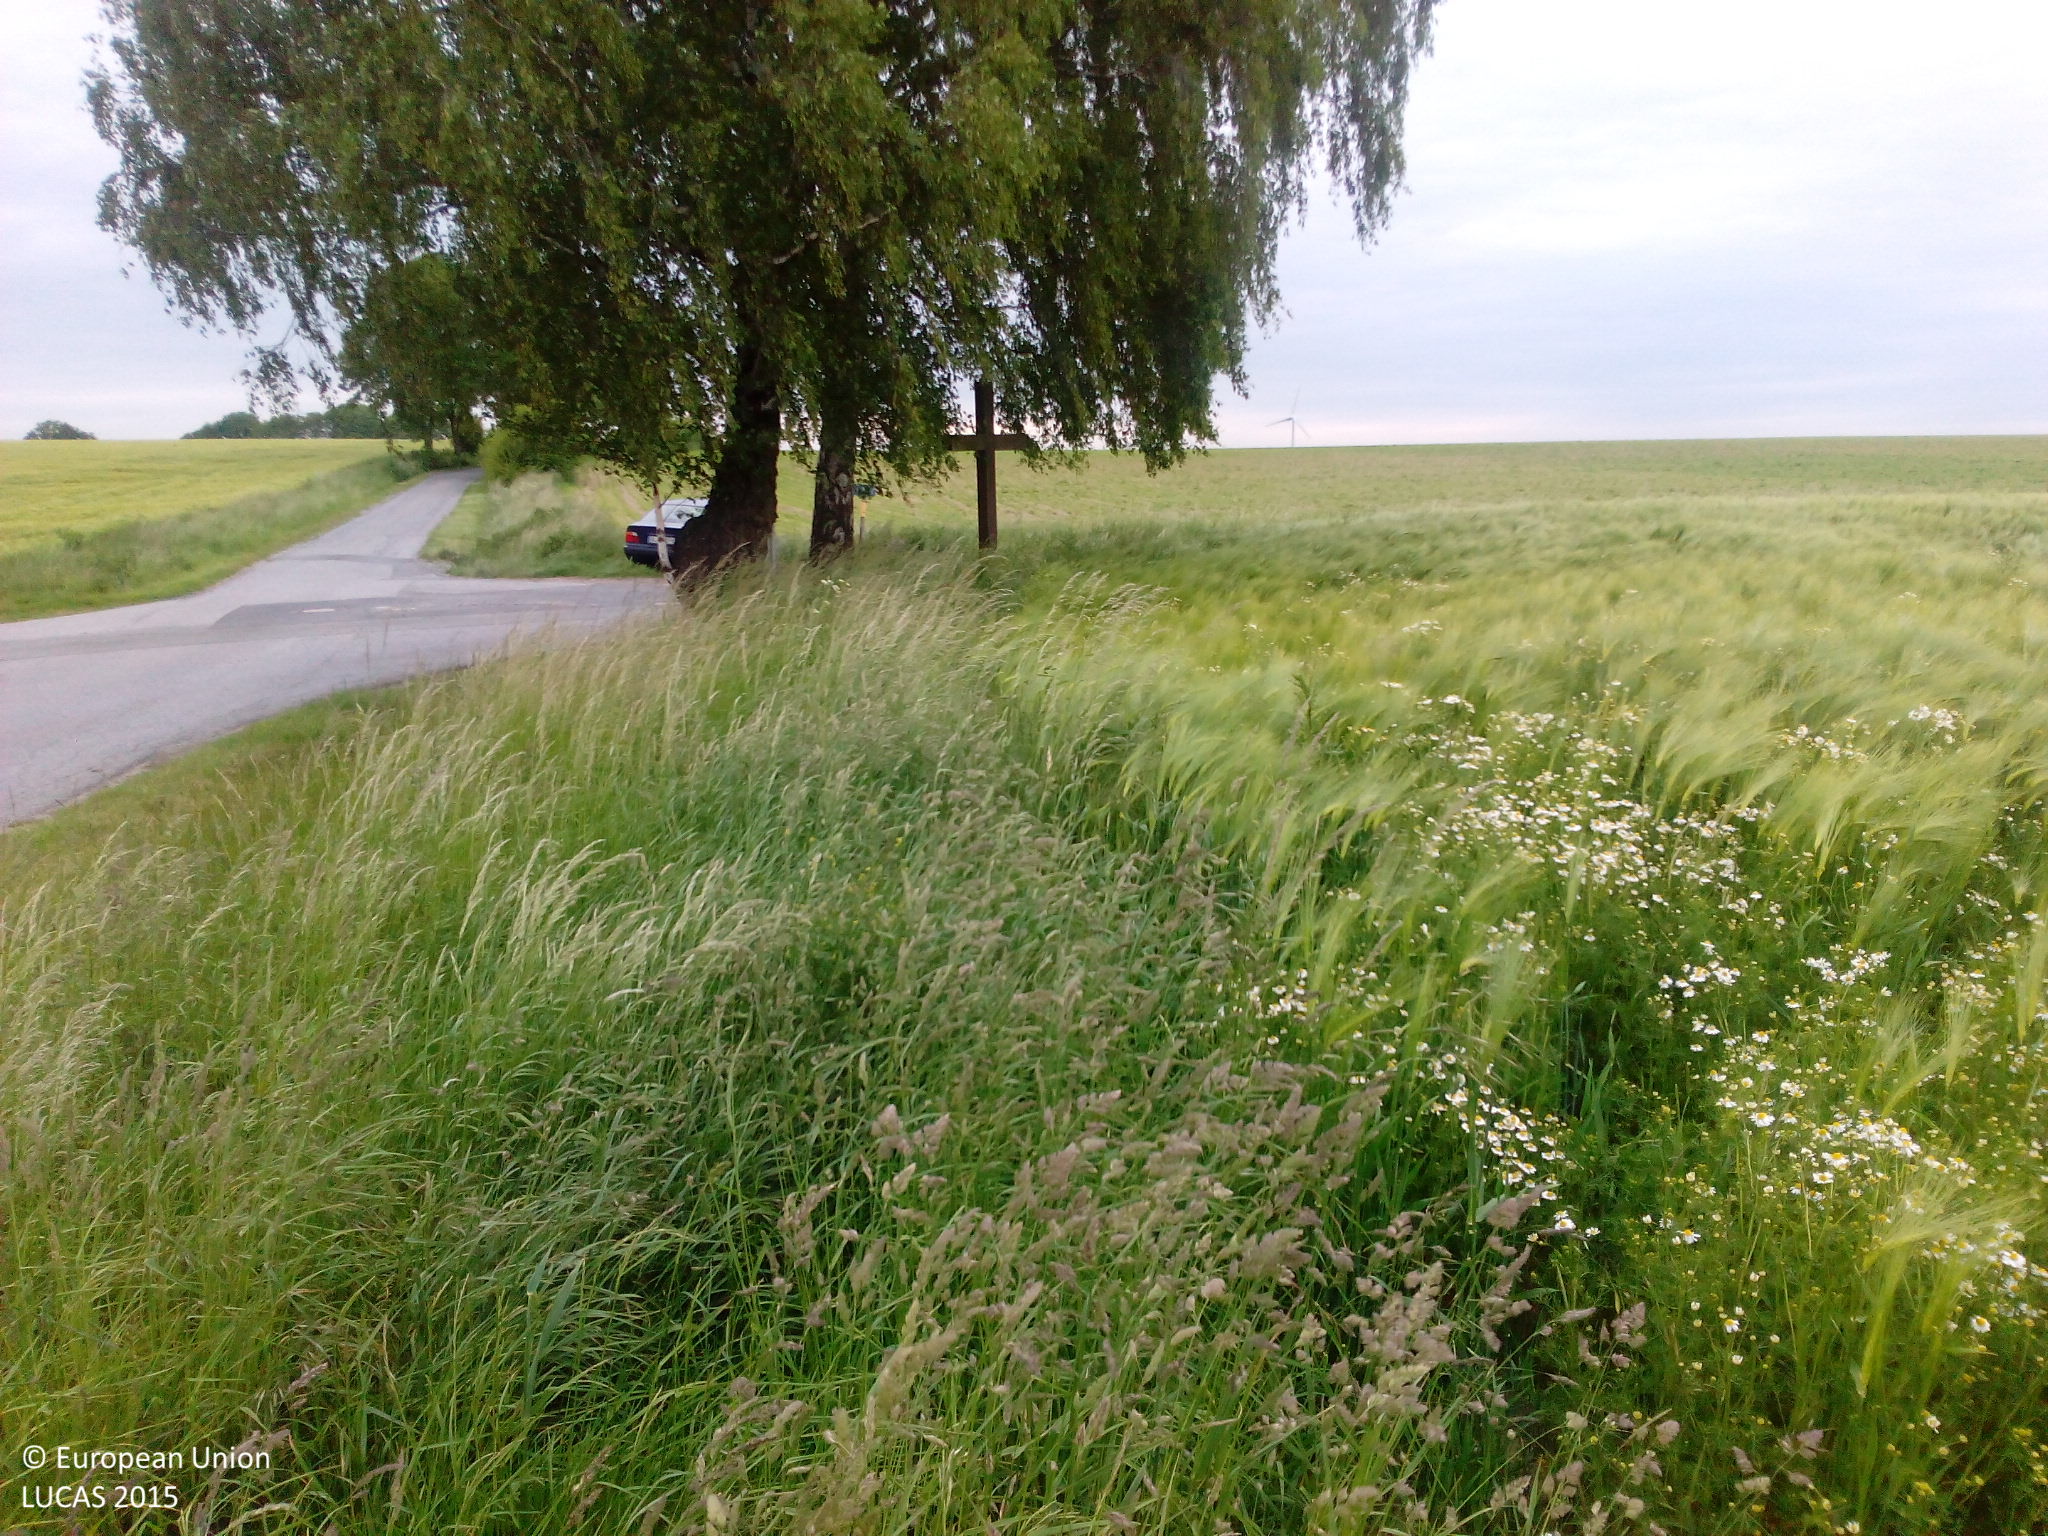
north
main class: Cropland
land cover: Barley
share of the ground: > 75 %
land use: Agriculture (excluding fallow land and kitchen gardens)
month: June
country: DE
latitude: 51.5155
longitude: 7.9973
